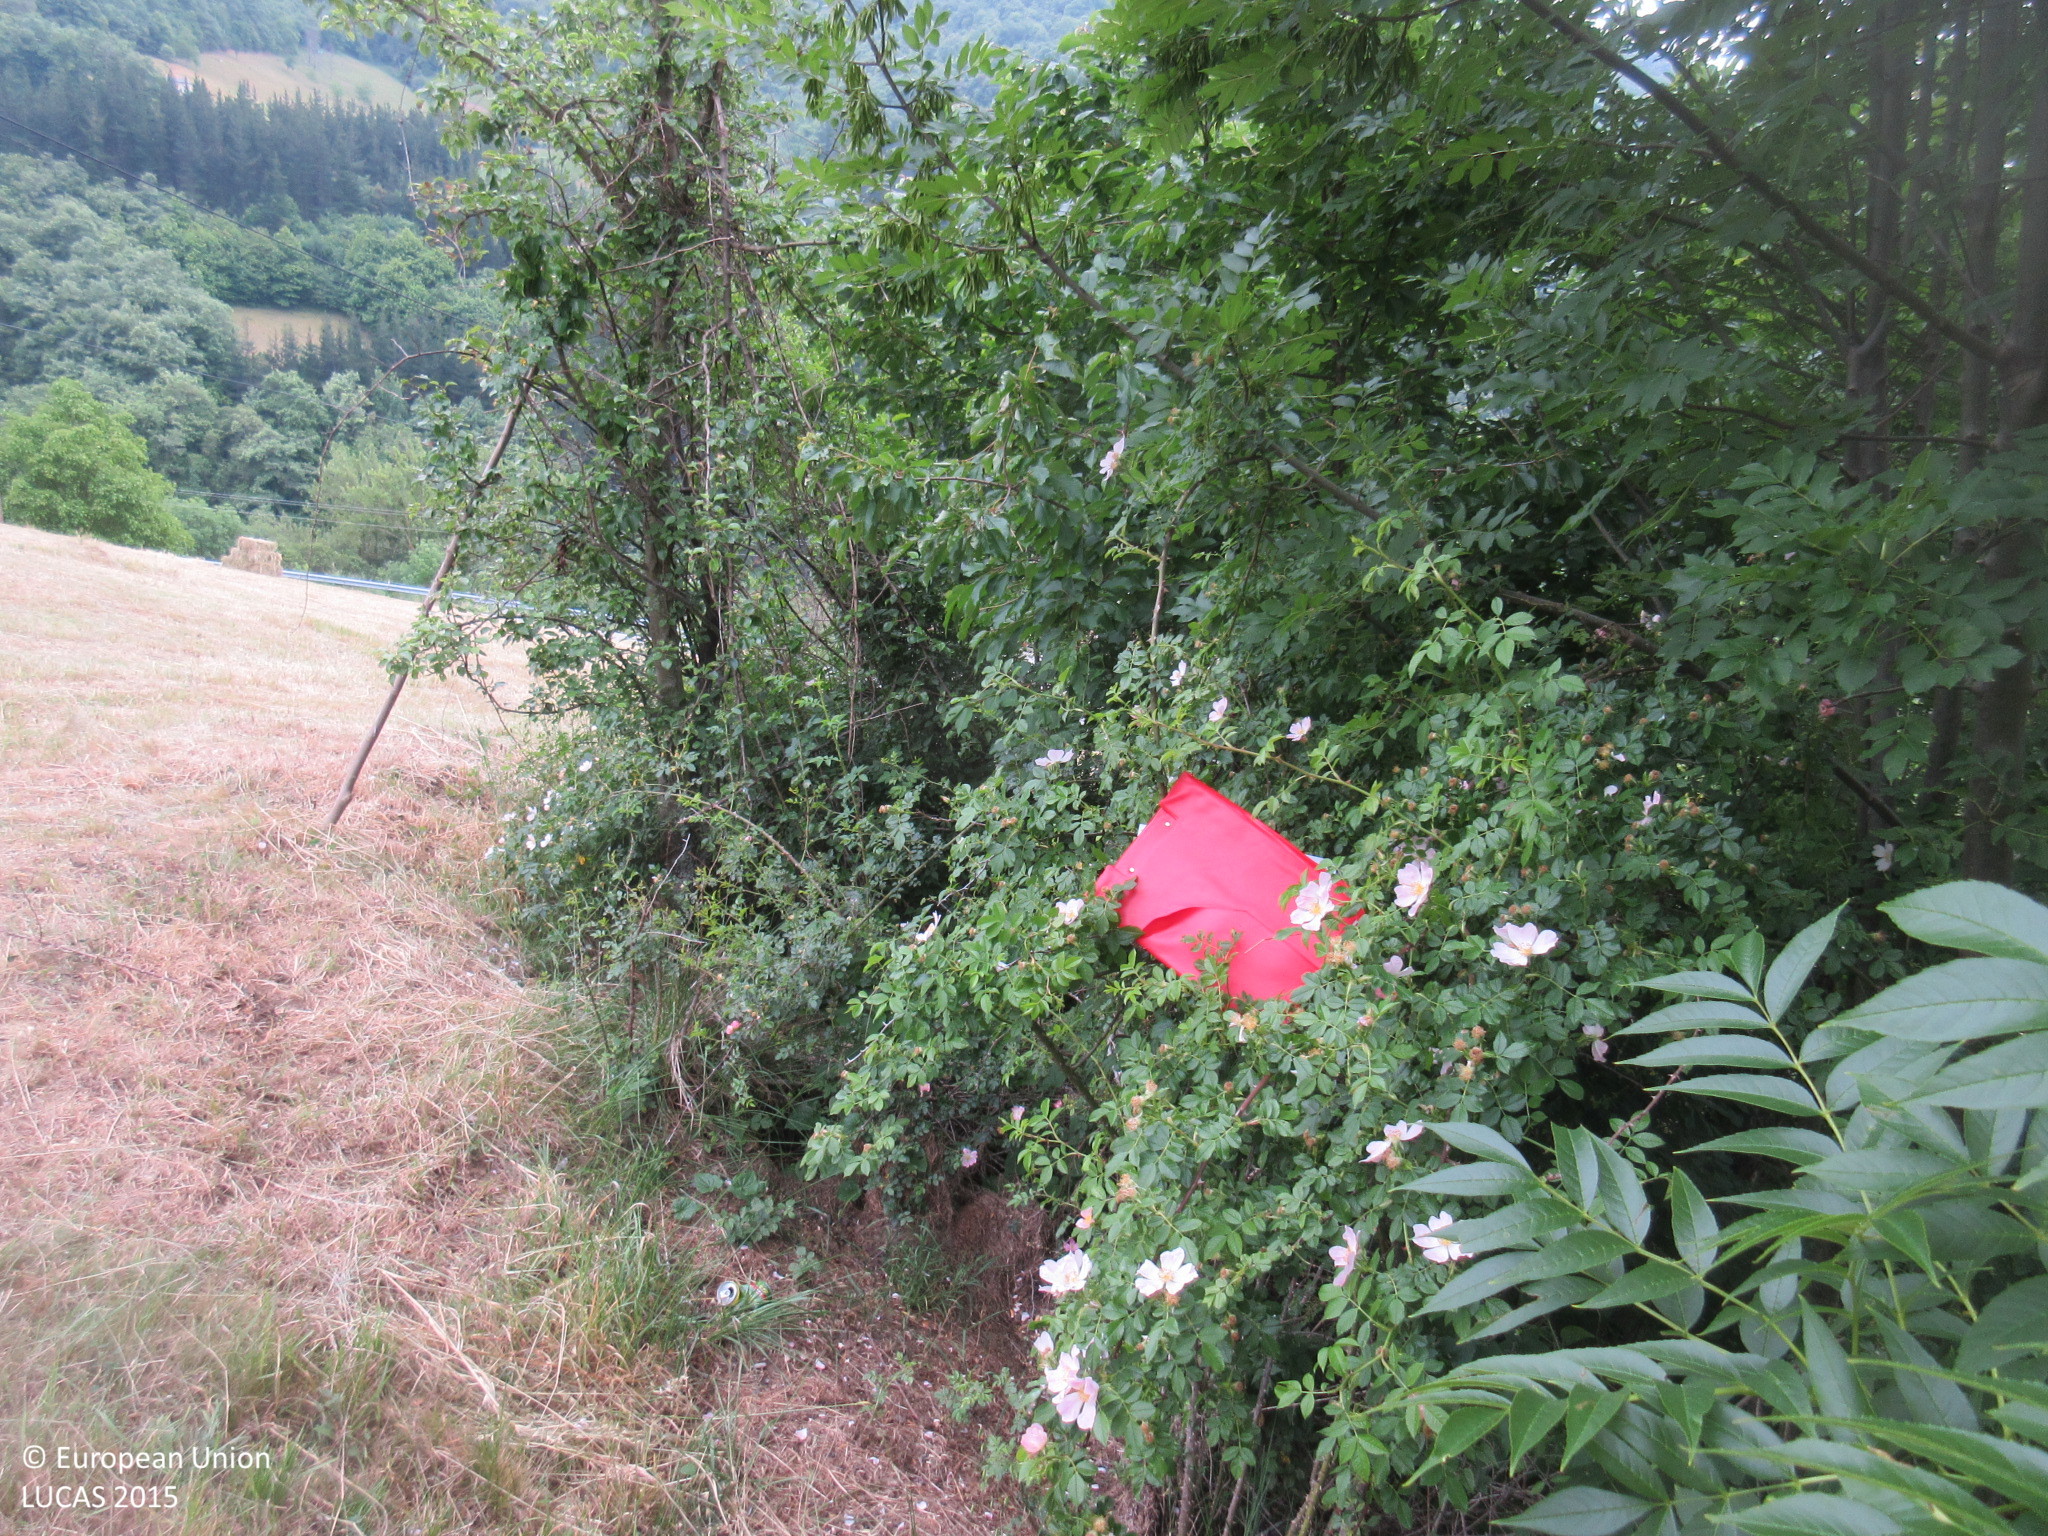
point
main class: Woodland
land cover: Broadleaved woodland
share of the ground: > 75 %
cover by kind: broadleaved forest trees 75 %, shrubs 25 %
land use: Semi-natural and natural areas not in use
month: June
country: ES
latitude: 43.1527
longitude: -4.5576
